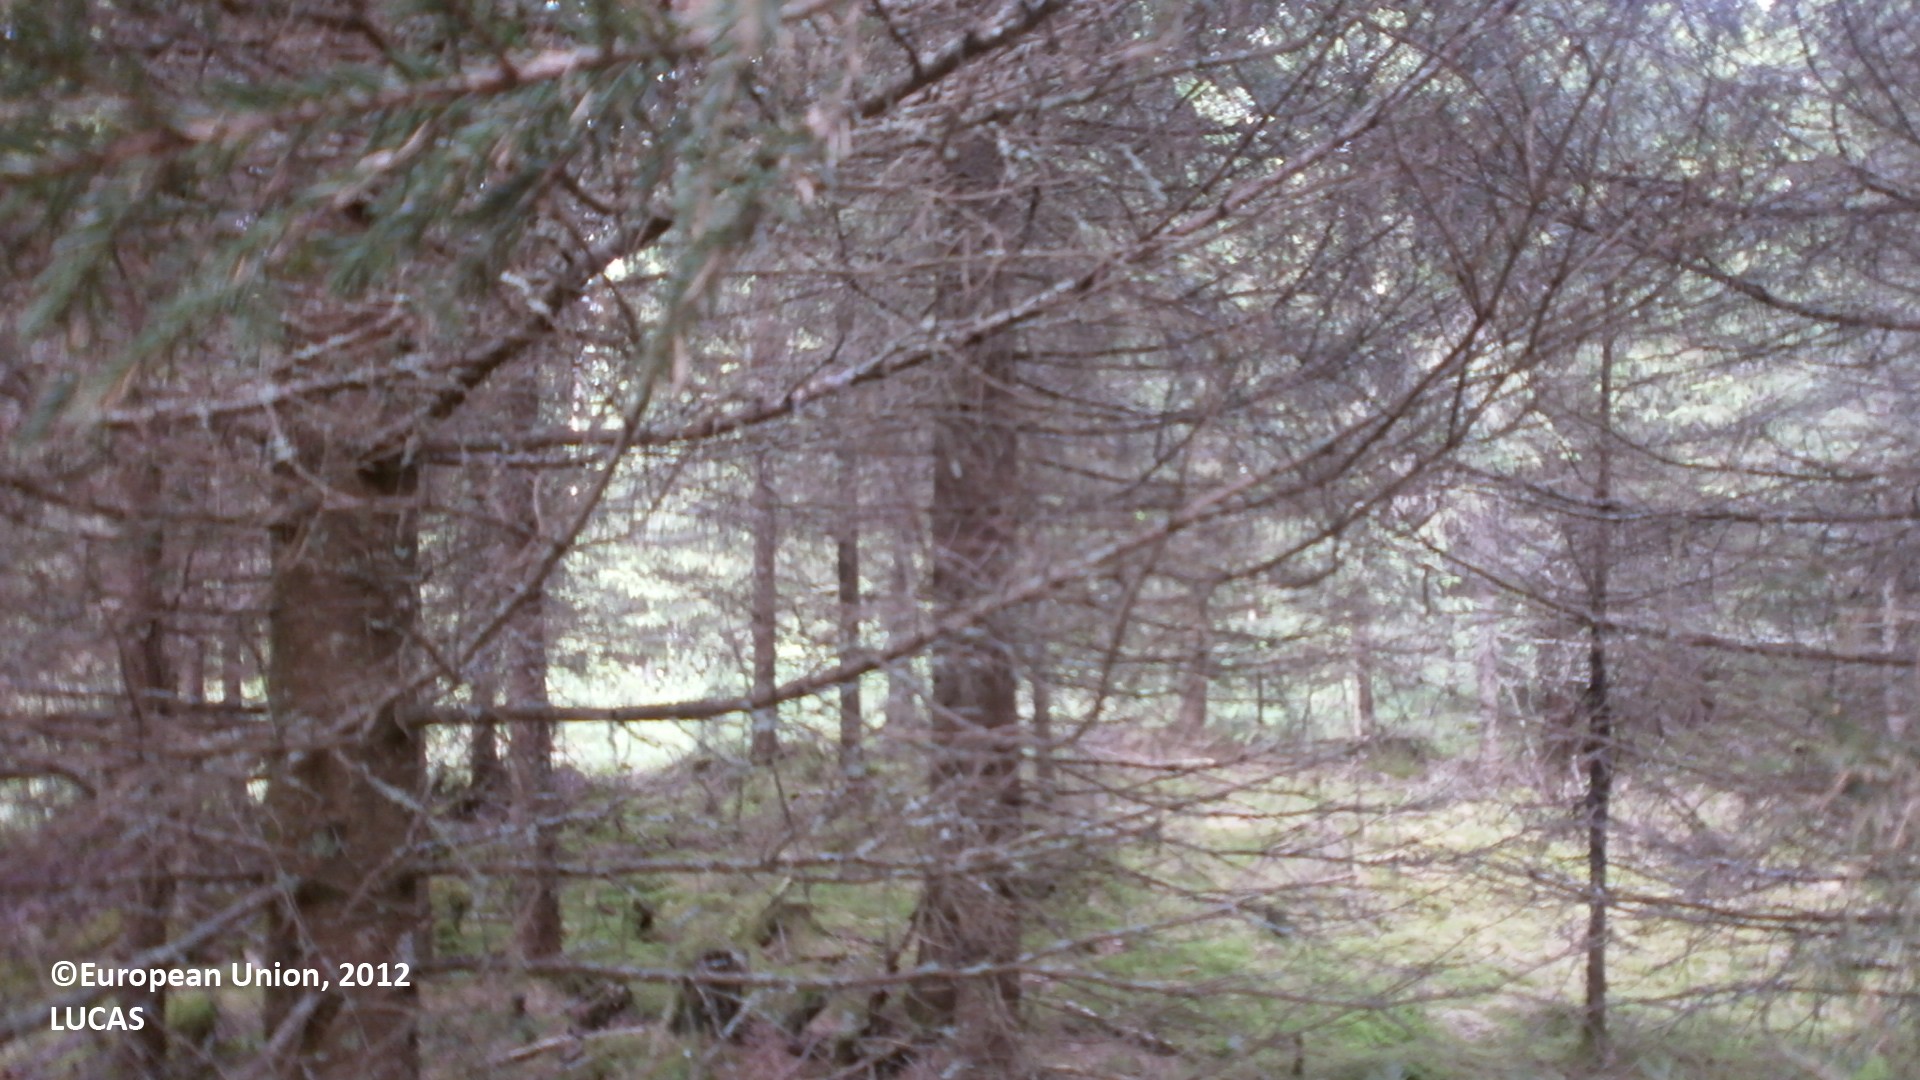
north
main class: Woodland
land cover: Spruce dominated coniferous woodland
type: boreal forest
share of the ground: > 75 %
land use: Forestry
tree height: > 5 m
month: July
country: FI
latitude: 64.2342
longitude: 24.4001
